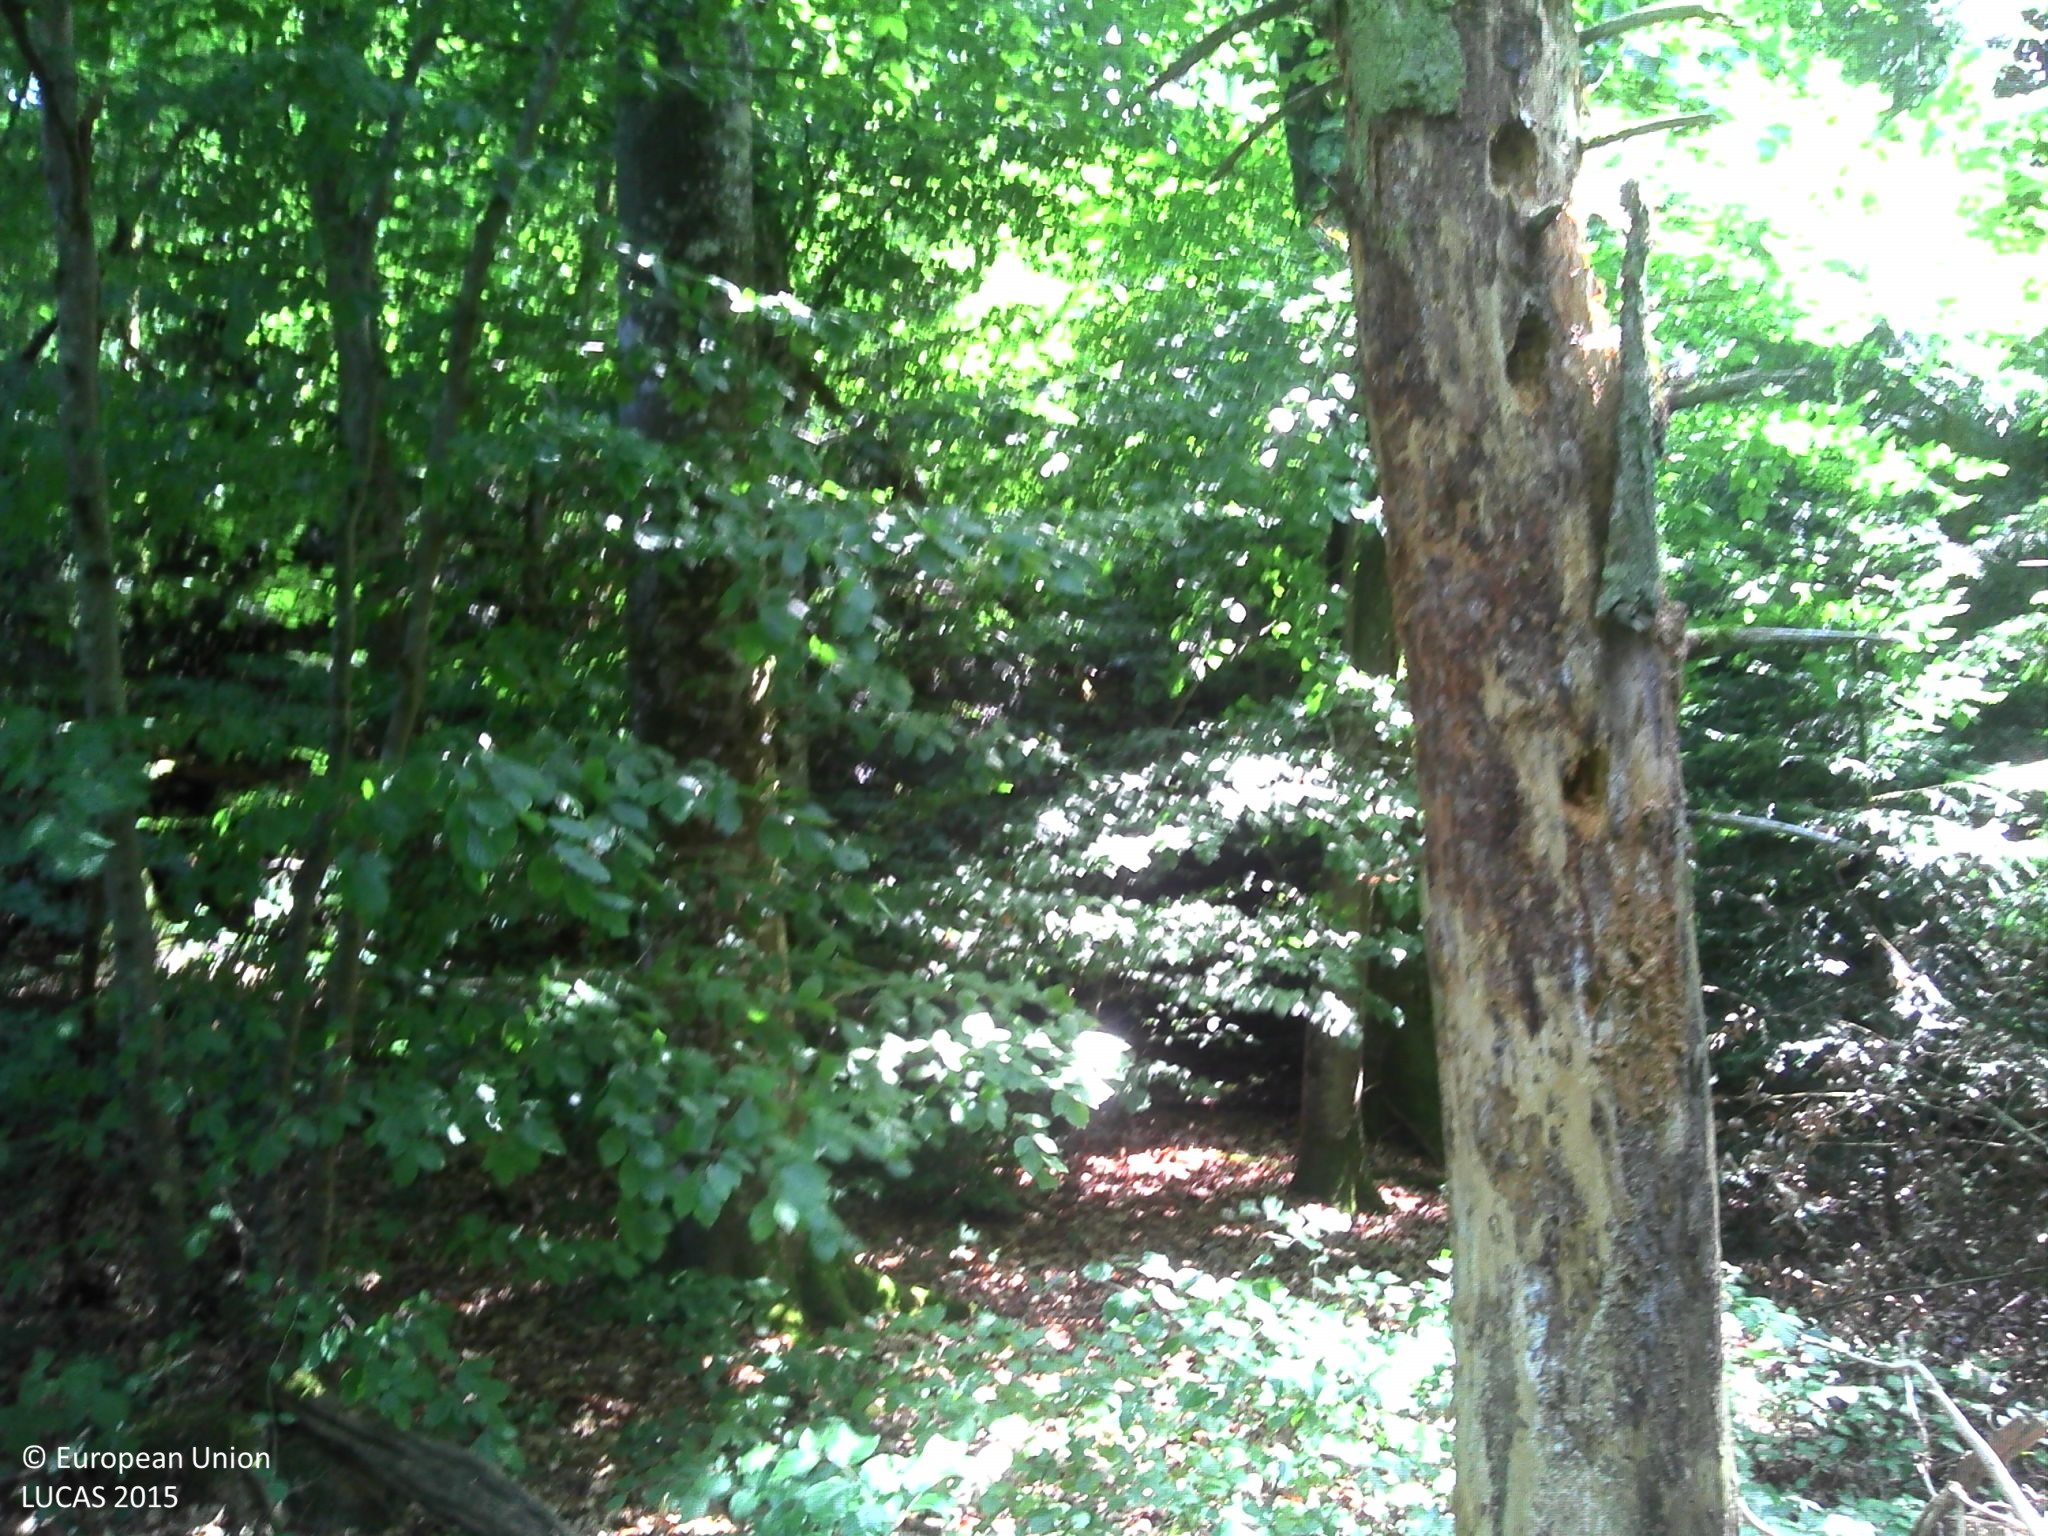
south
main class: Woodland
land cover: Broadleaved woodland
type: beech forest
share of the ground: > 75 %
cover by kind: broadleaved forest trees 50 %, herbaceous plants 25 %, coniferous forest trees 15 %, shrubs 10 %
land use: Forestry
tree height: > 5 m
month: June
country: FR
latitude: 46.3697
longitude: 4.4509
